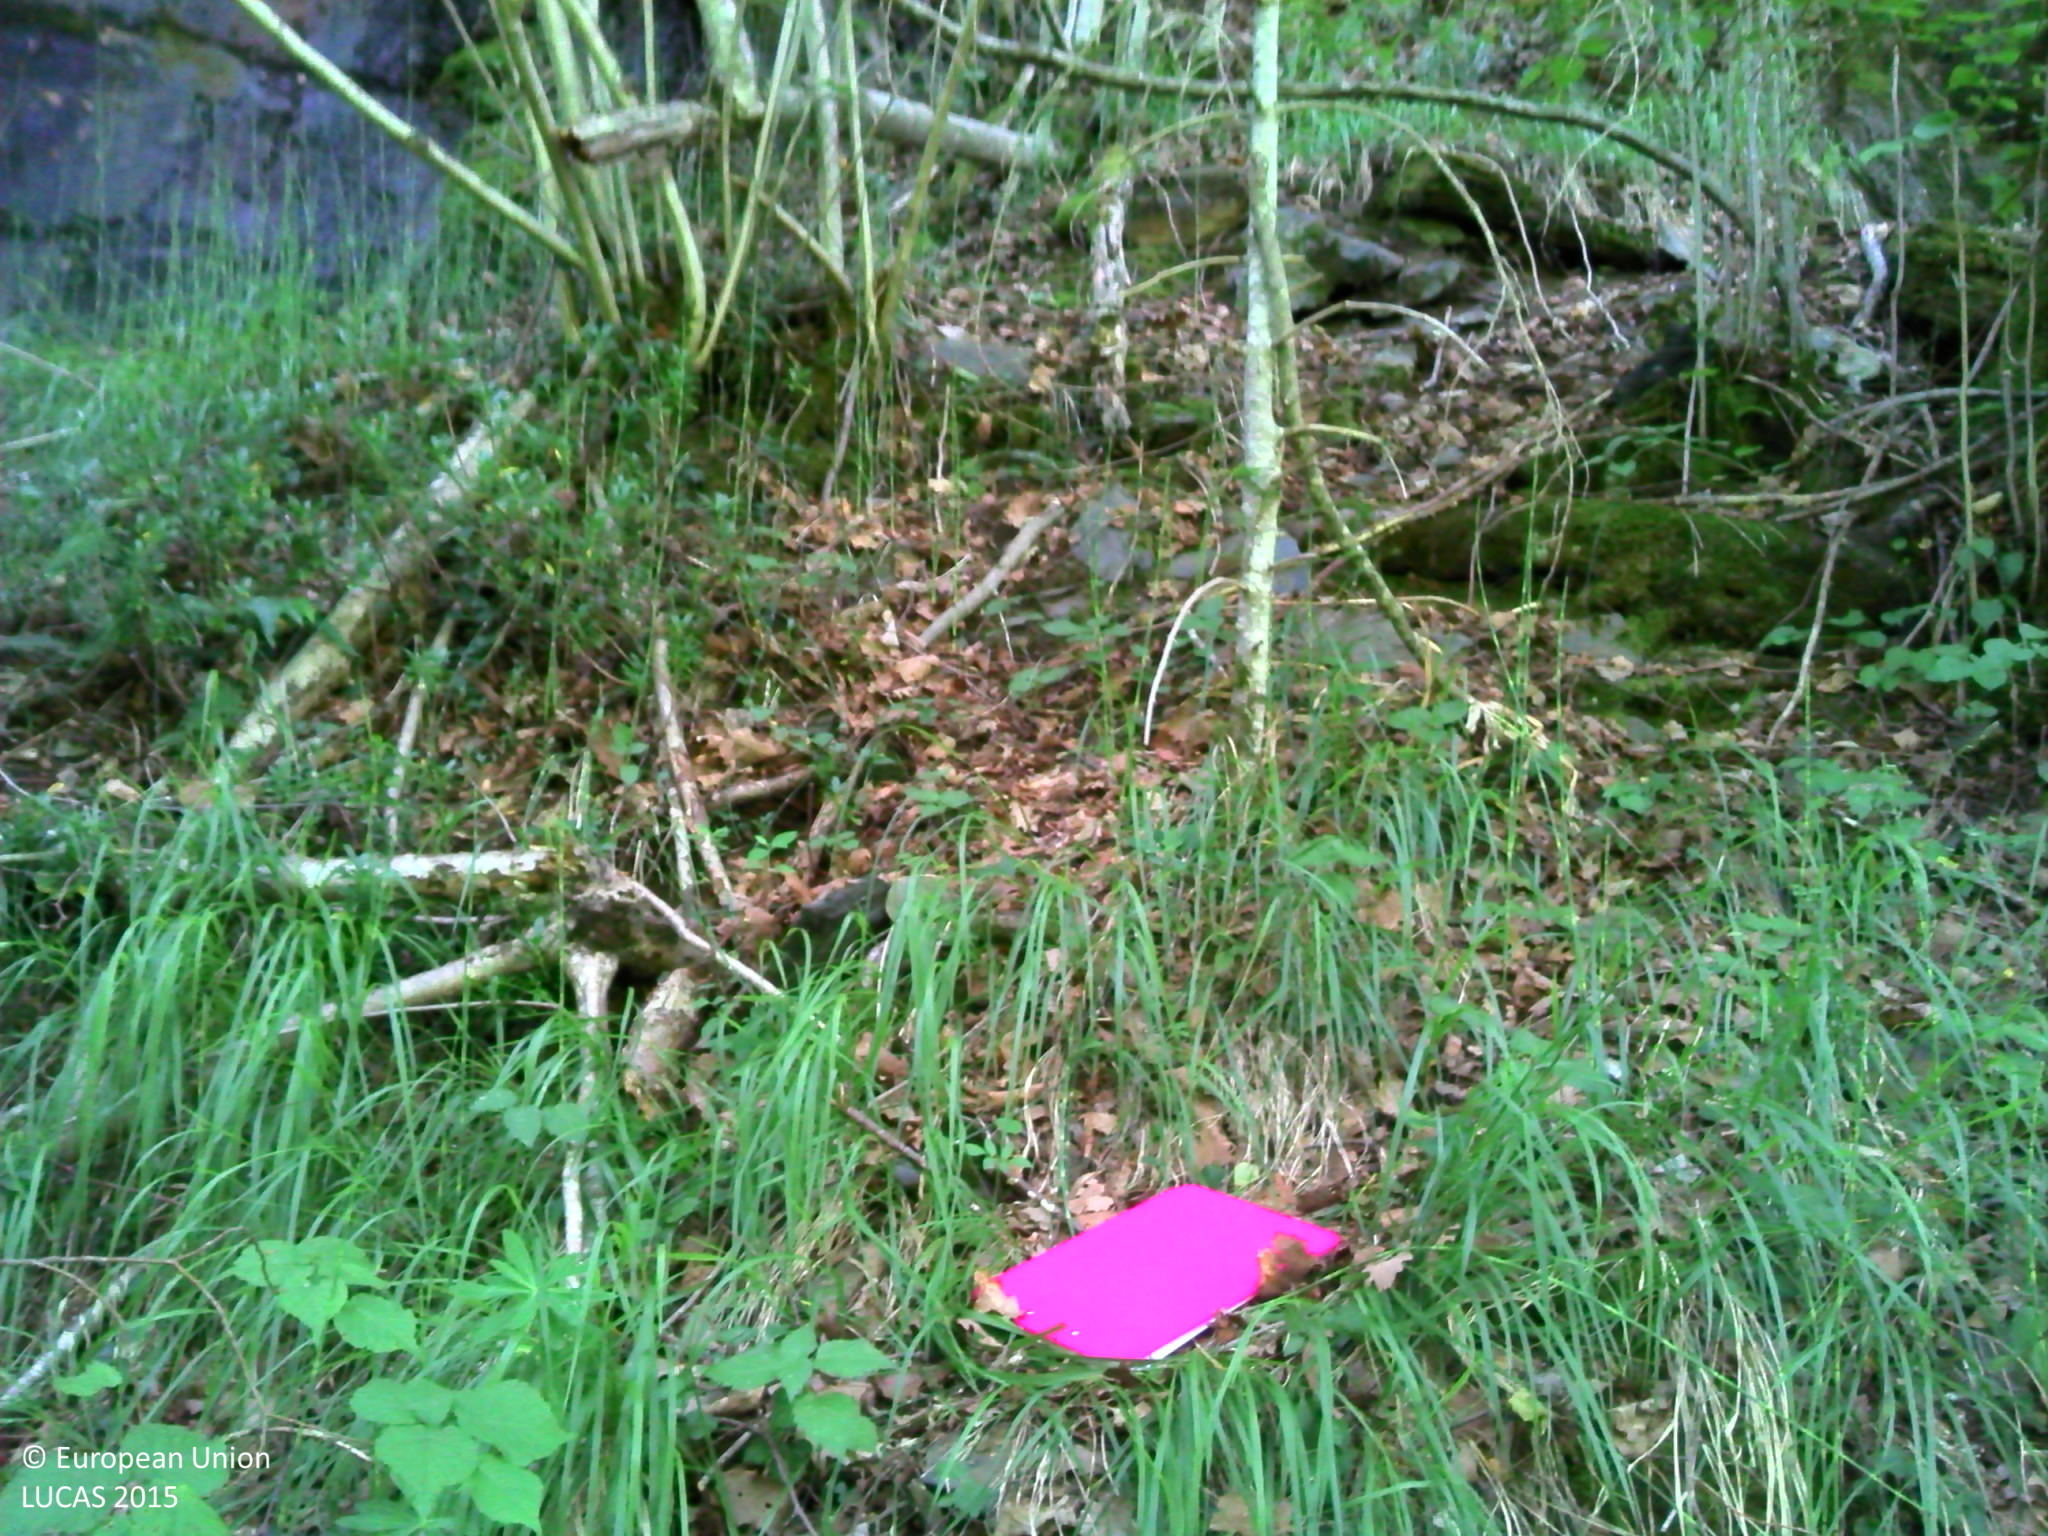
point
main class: Woodland
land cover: Broadleaved woodland
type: mesophytic deciduous forest
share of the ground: > 75 %
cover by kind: broadleaved forest trees 80 %, unconsolidated bare surface 10 %, shrubs 5 %, herbaceous plants 5 %
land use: Semi-natural and natural areas not in use
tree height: > 5 m
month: July
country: FR
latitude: 42.9312
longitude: -0.0863
